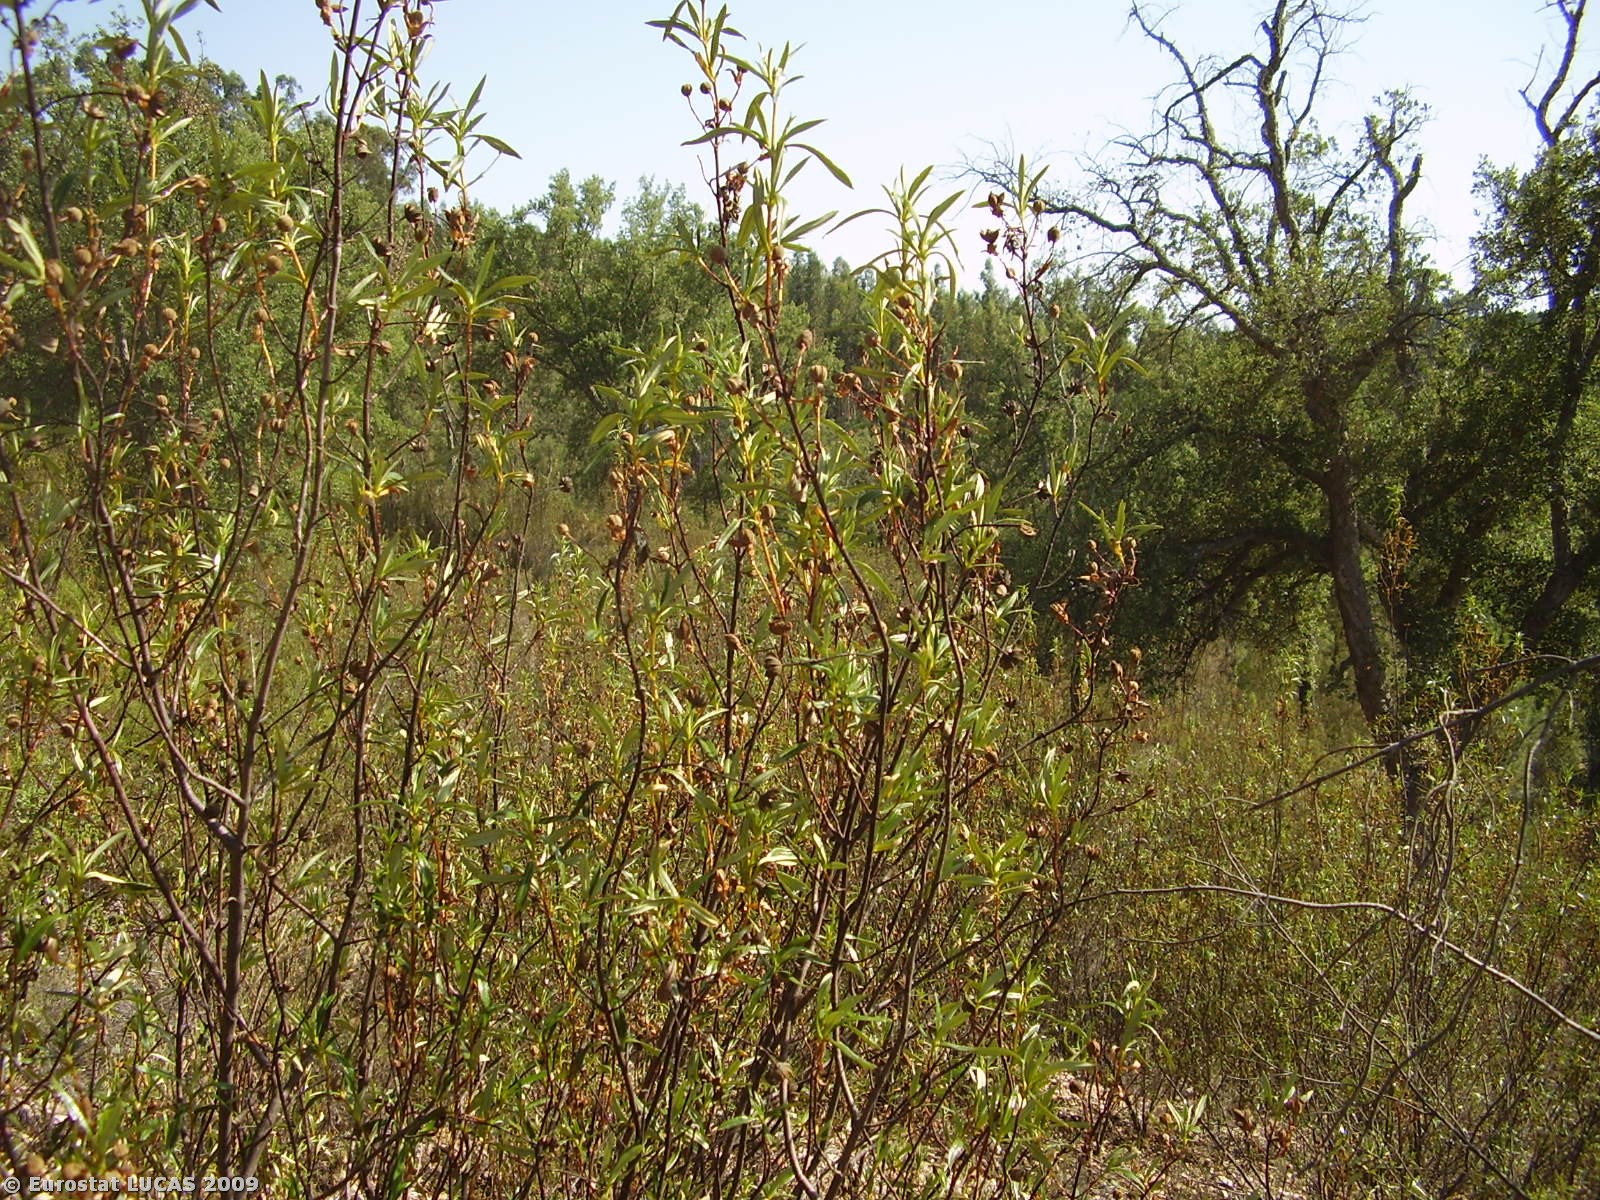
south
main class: Woodland
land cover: Broadleaved woodland
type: broadleaved evergreen forest
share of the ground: 10 - 25 %
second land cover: Shrubland with sparse tree cover
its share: > 75 %
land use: Forestry
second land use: Fallow land
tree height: > 5 m
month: July
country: PT
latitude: 39.4095
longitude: -8.0488
